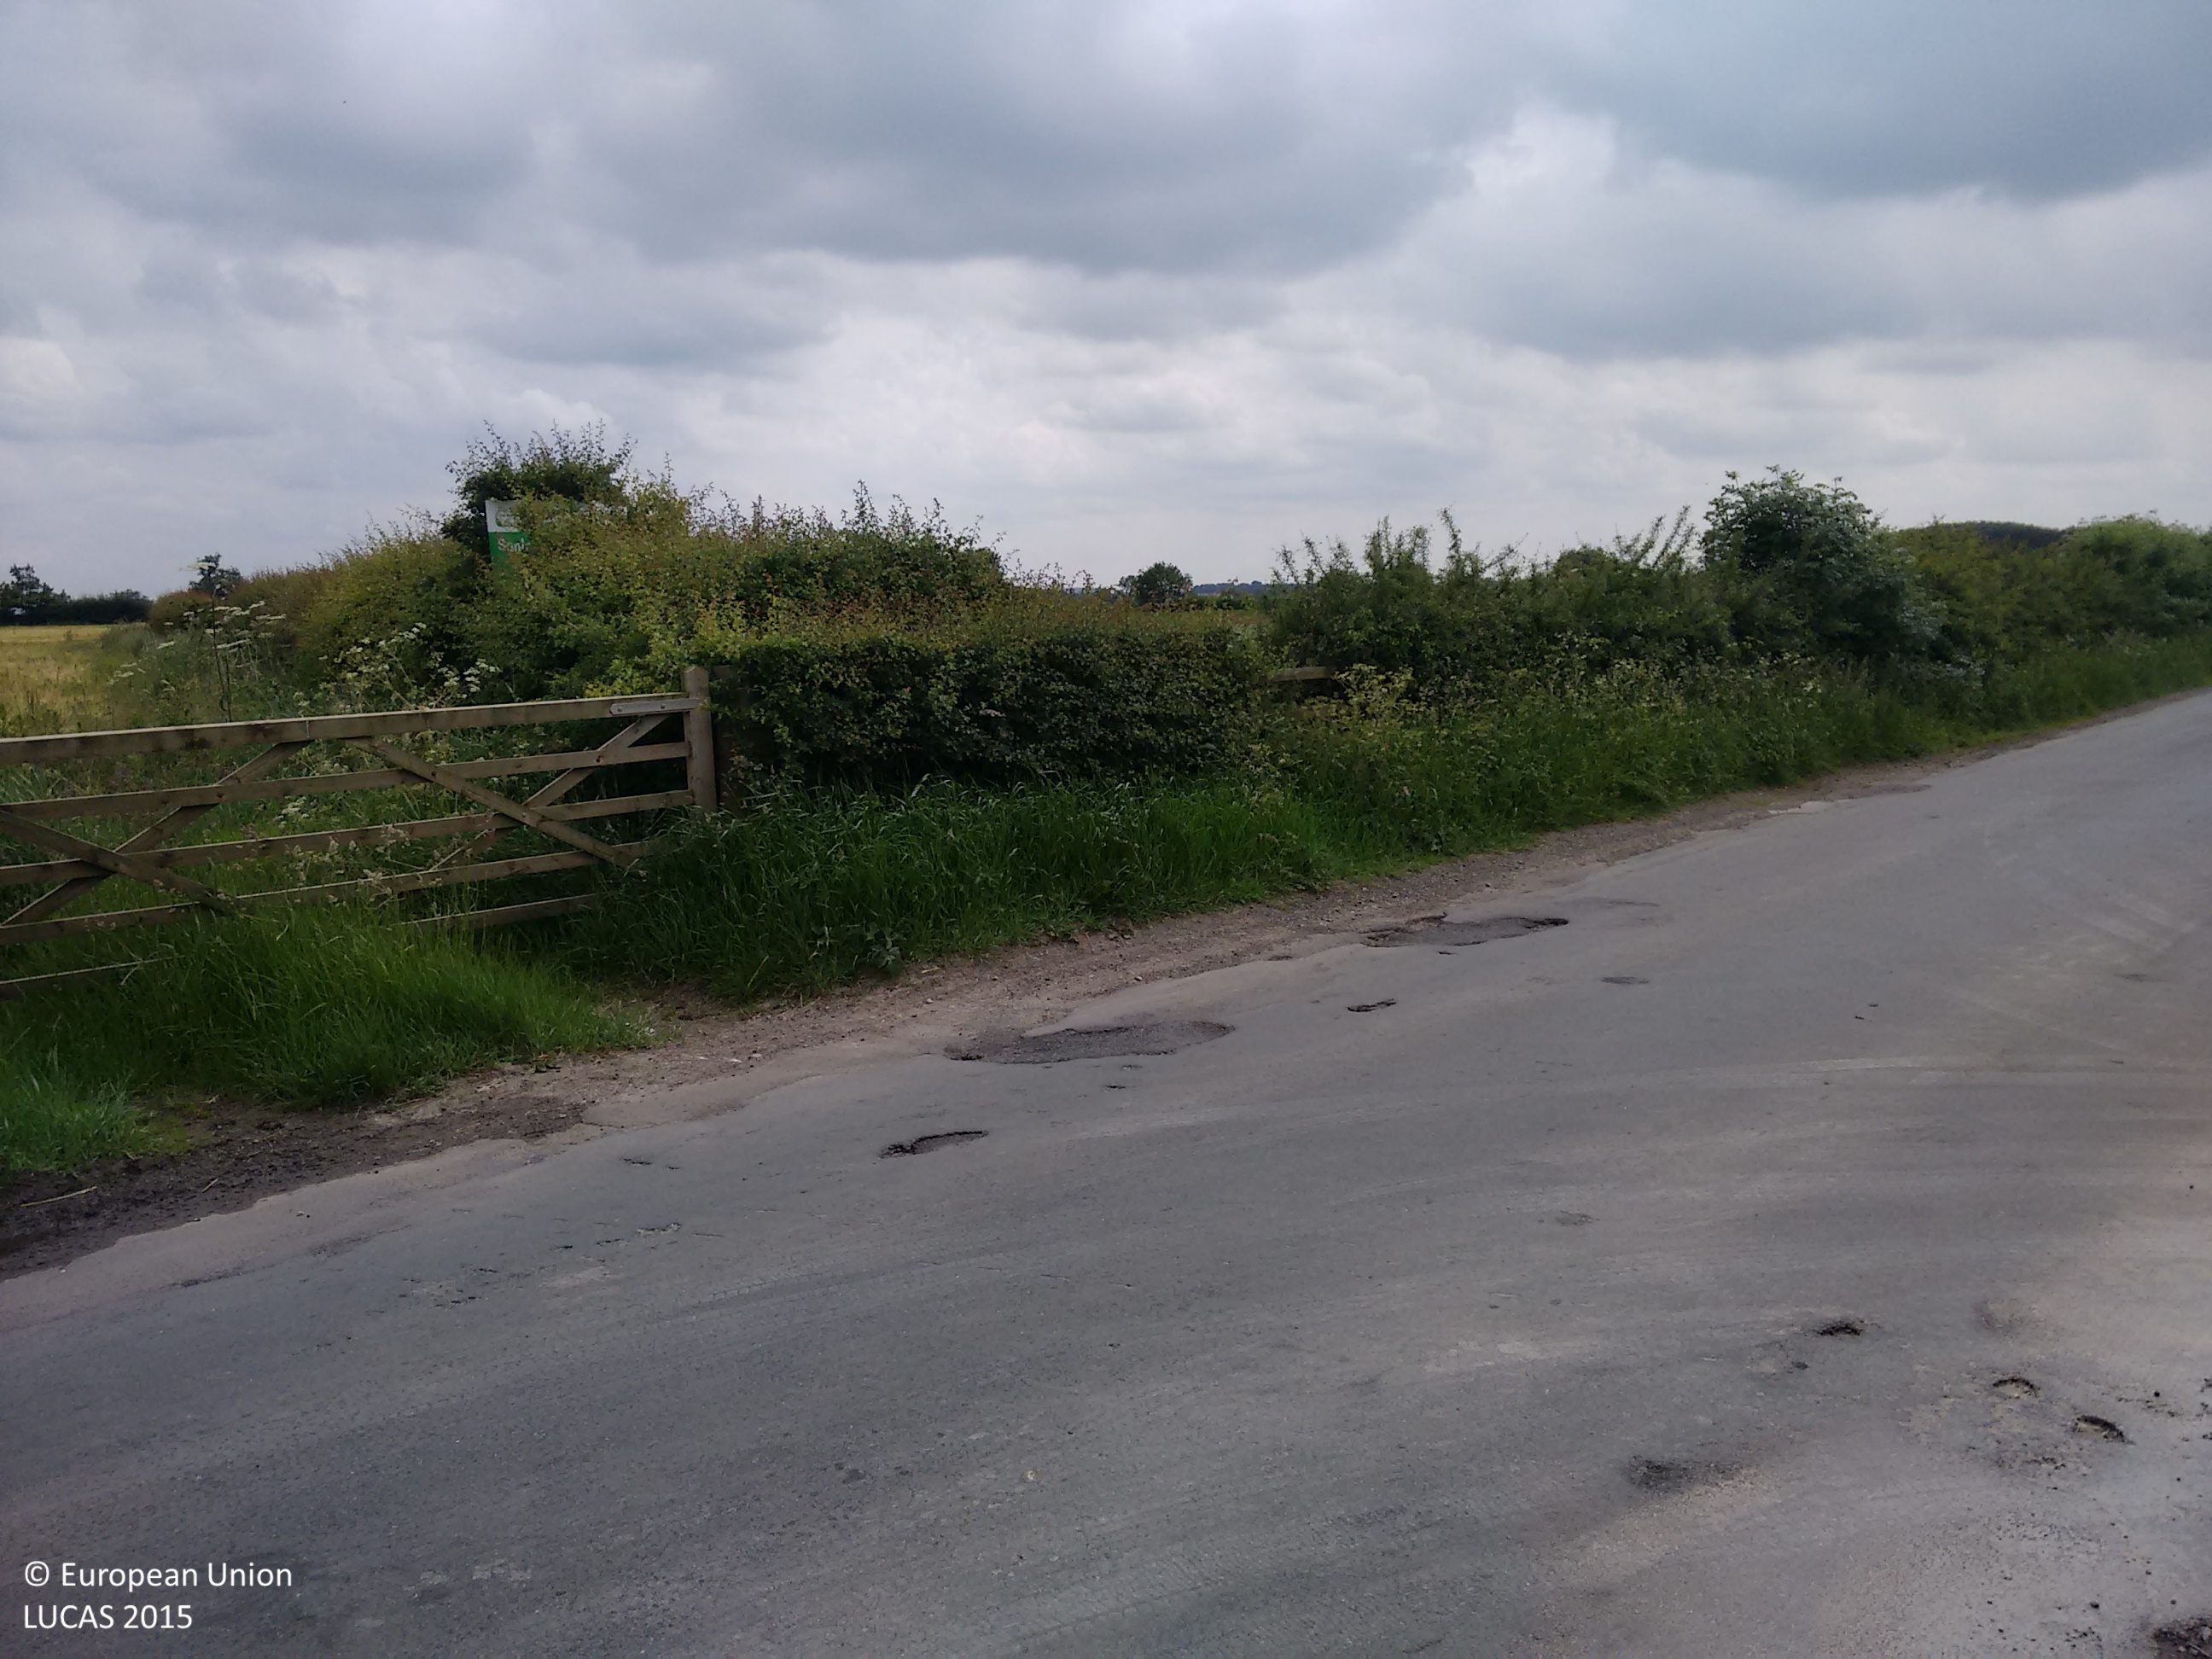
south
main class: Cropland
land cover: Common wheat
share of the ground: > 75 %
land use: Agriculture (excluding fallow land and kitchen gardens)
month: June
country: GB
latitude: 54.2289
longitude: -0.9483
